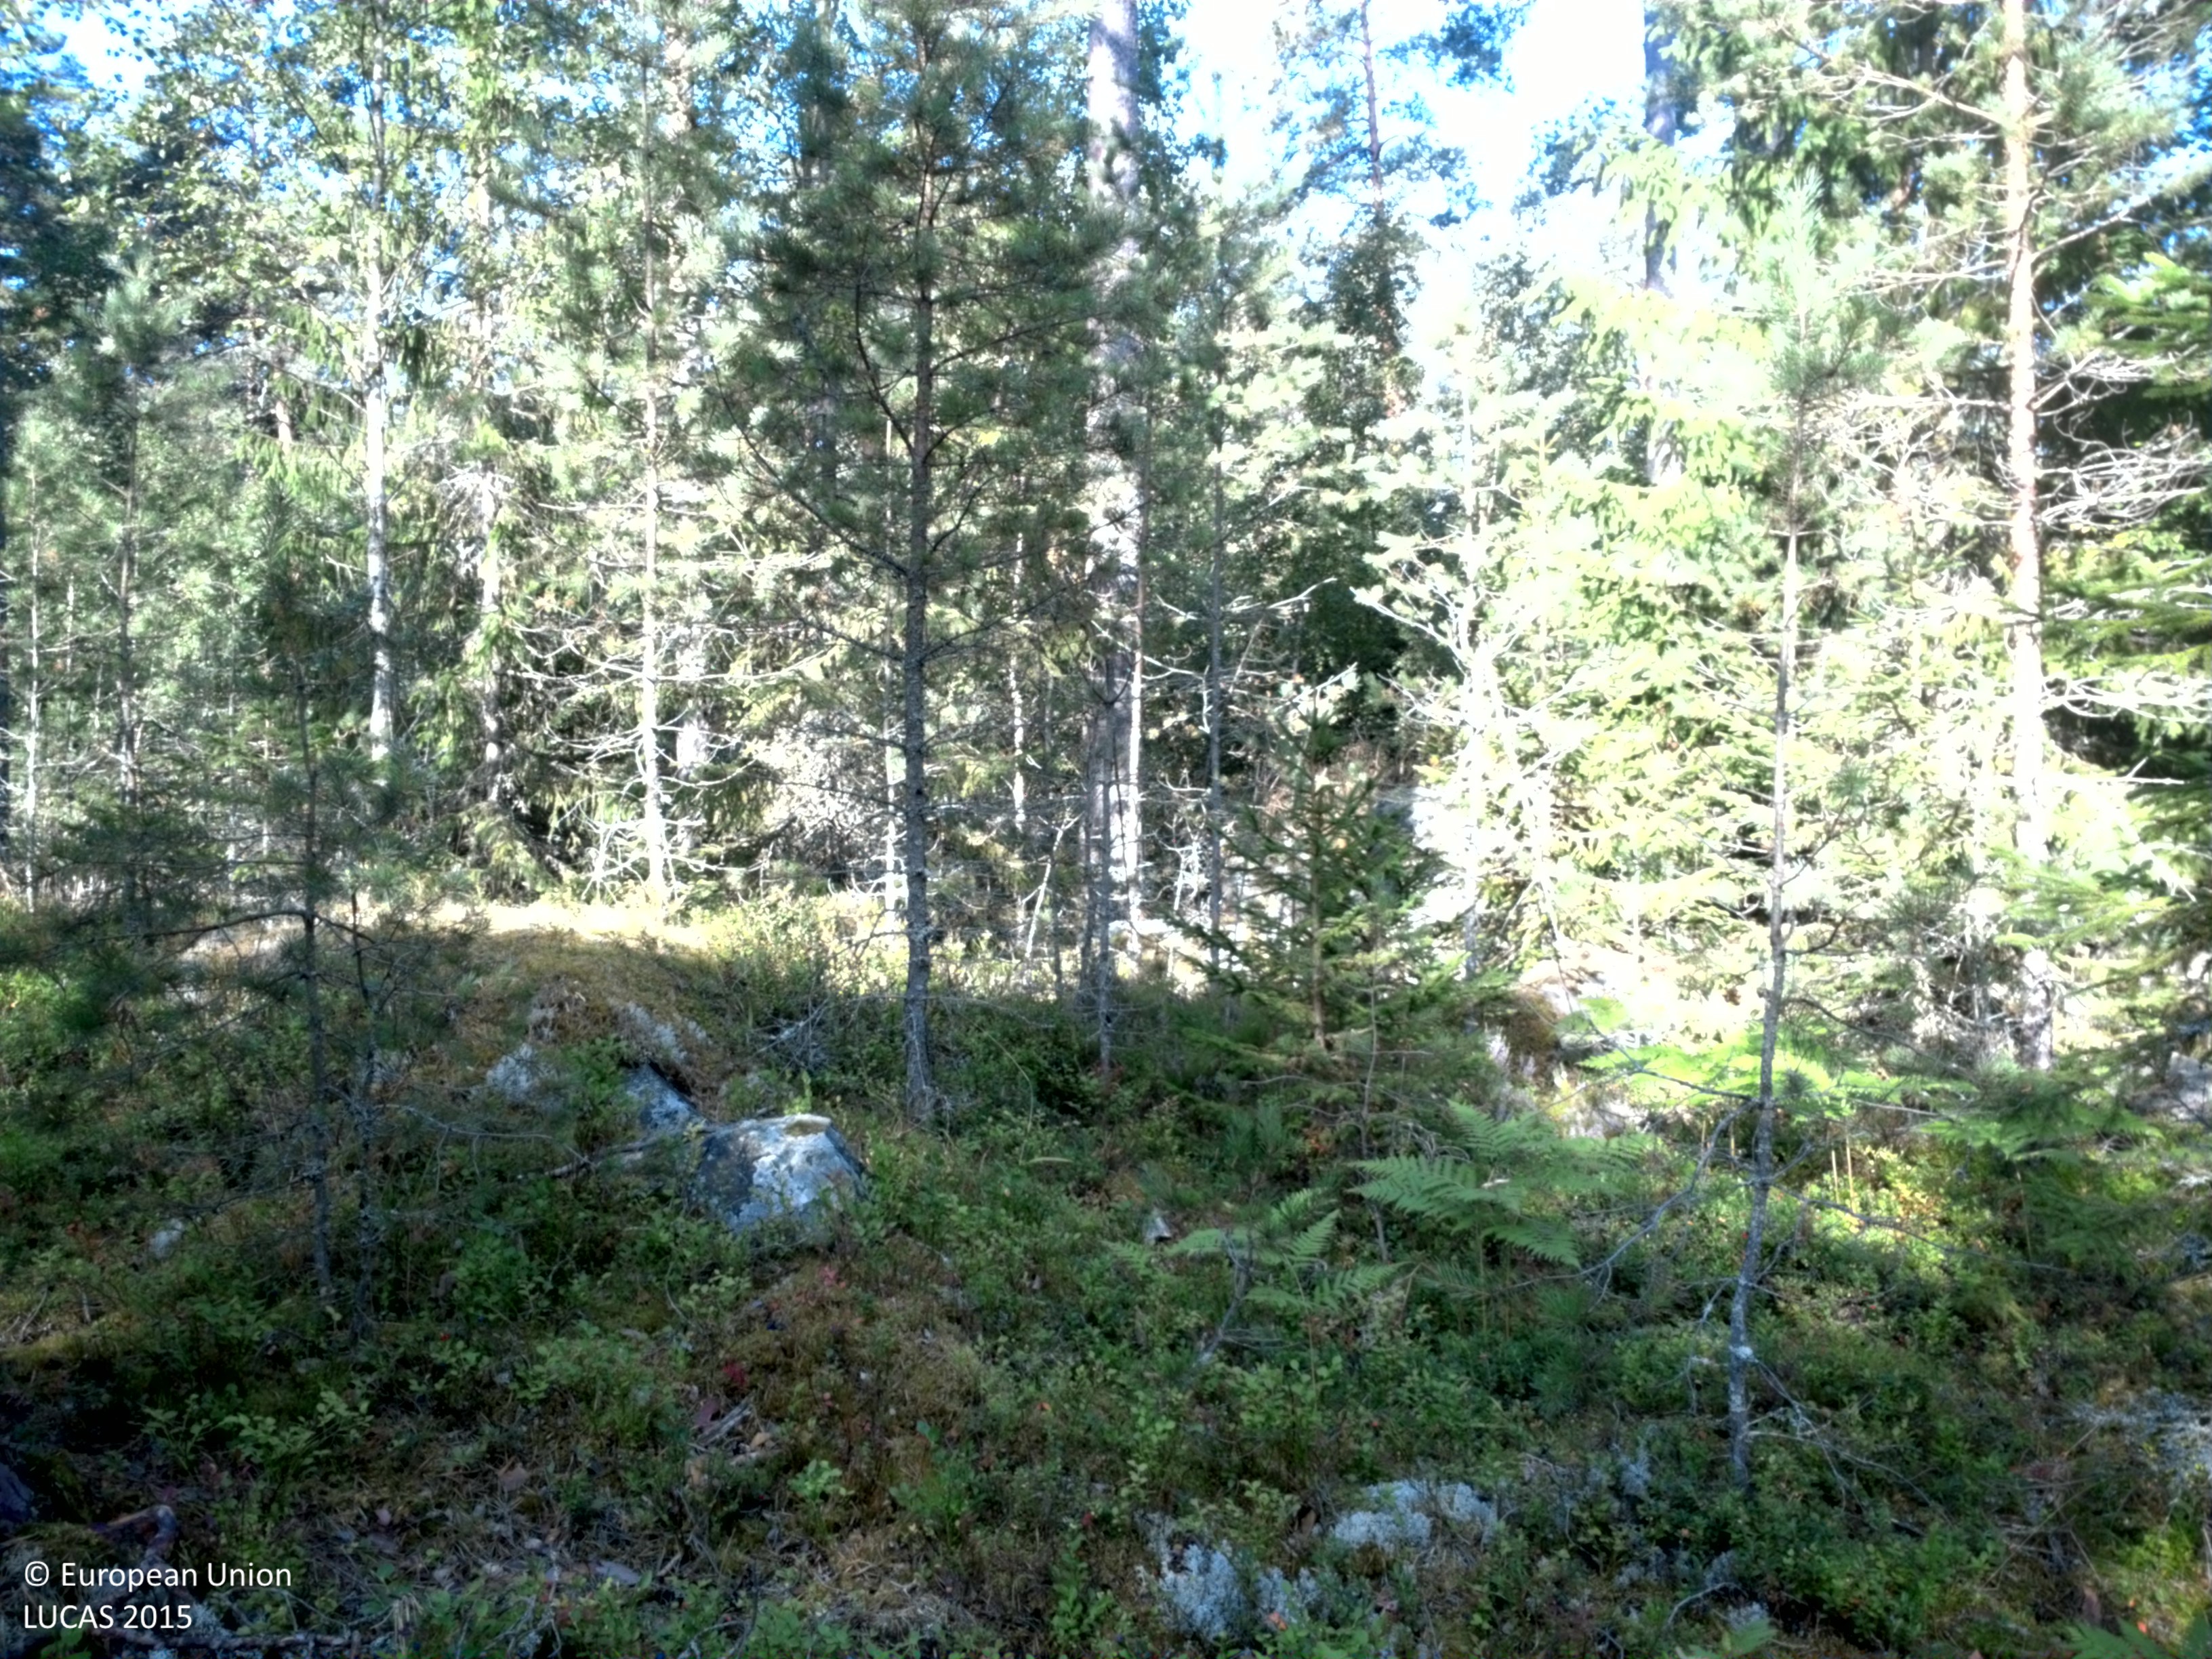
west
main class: Woodland
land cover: Pine dominated coniferous woodland
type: boreal forest
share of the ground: 50 - 75 %
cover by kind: coniferous forest trees 60 %, lichens and mosses 25 %, broadleaved forest trees 15 %
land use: Forestry
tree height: > 5 m
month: August
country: SE
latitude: 60.0190
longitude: 17.7984
